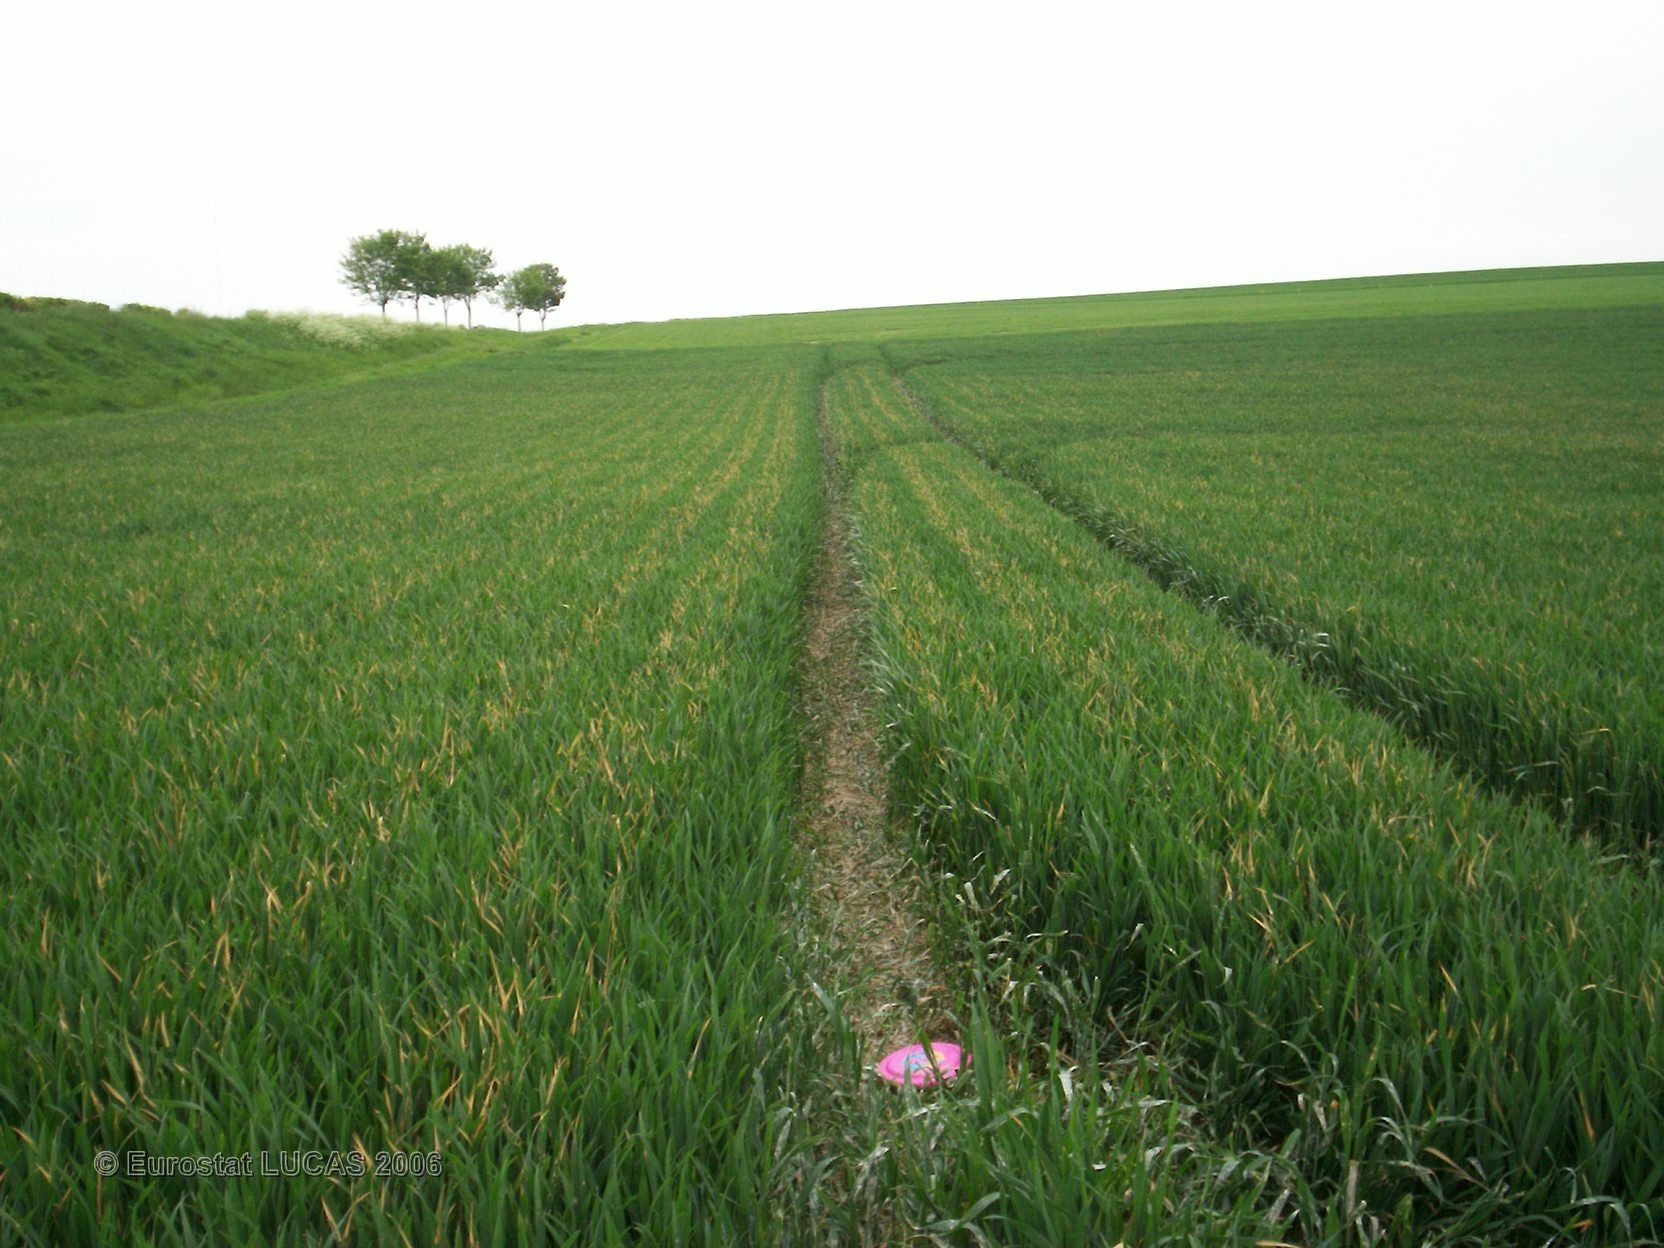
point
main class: Cropland
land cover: Common wheat
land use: Agriculture (excluding fallow land and kitchen gardens)
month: May
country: FR
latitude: 49.5377
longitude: 4.3162
